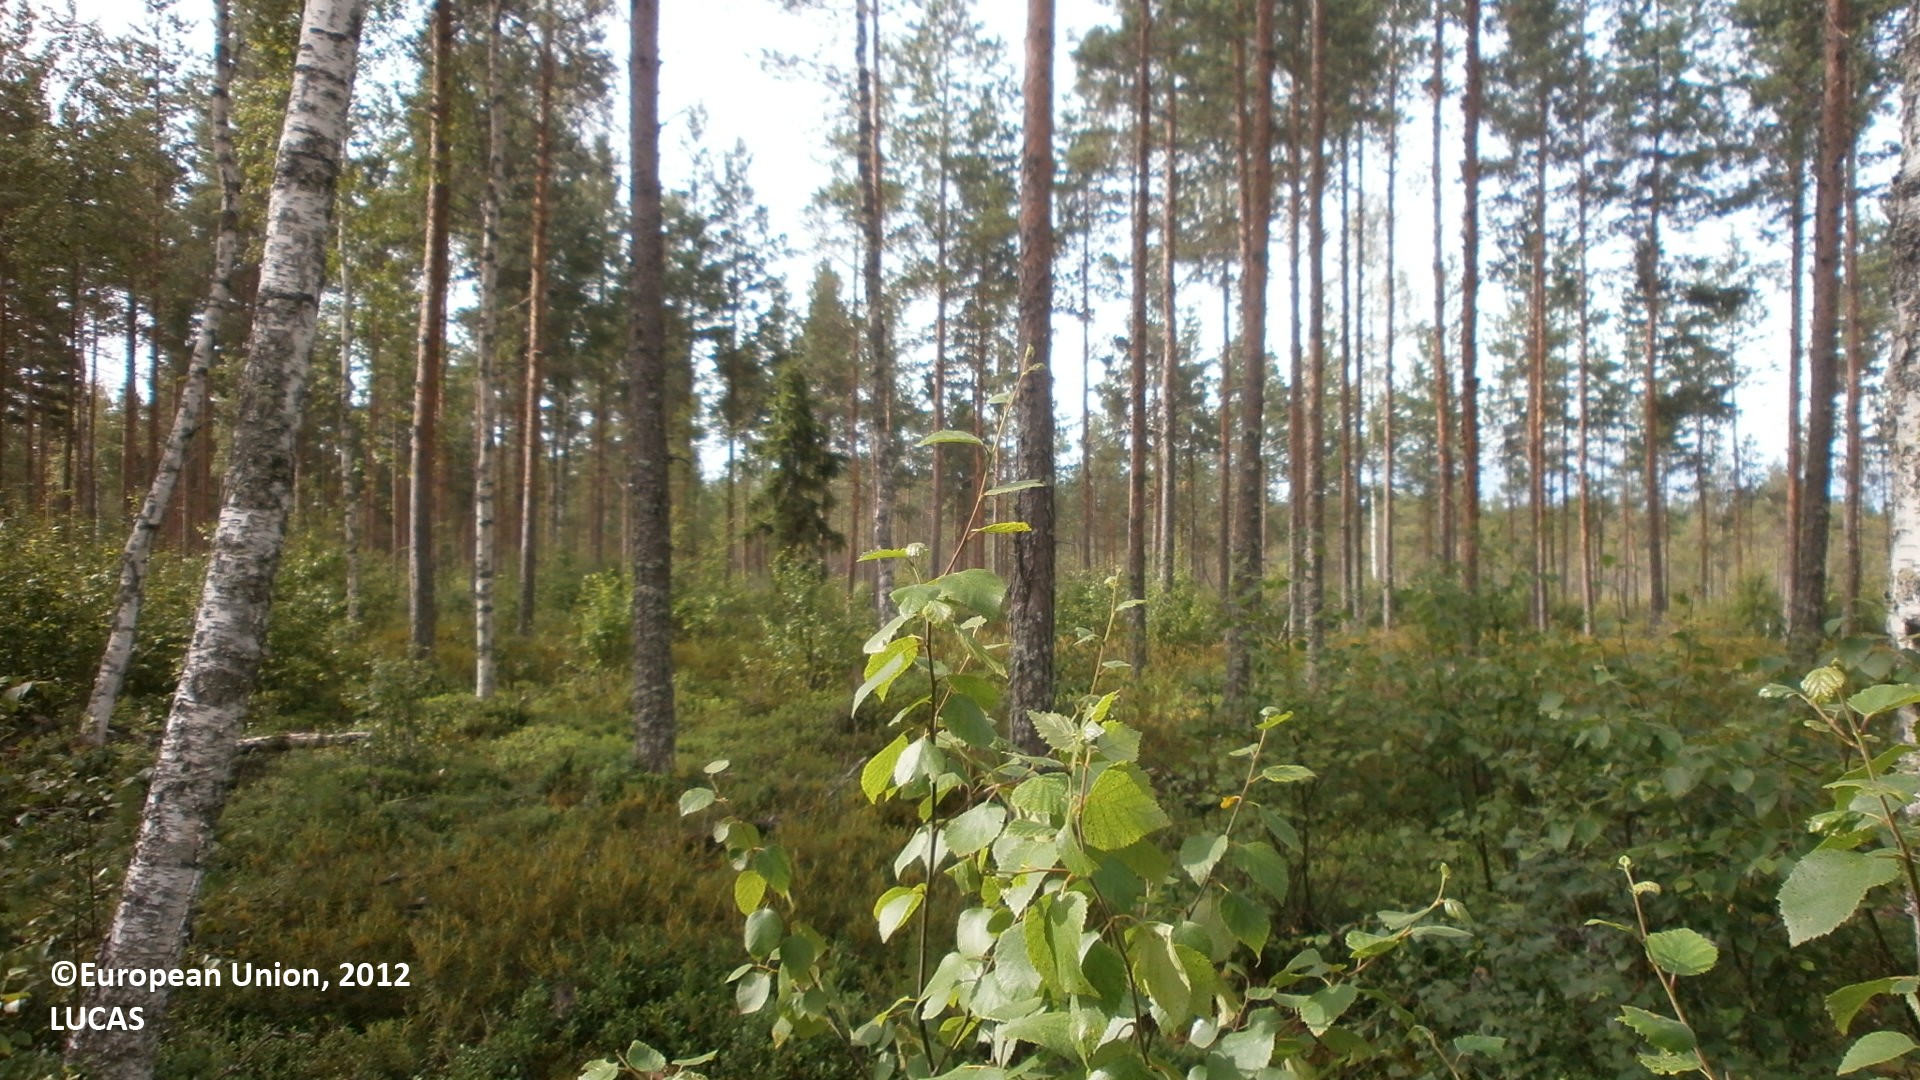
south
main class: Woodland
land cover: Broadleaved woodland
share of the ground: 50 - 75 %
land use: Forestry
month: July
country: FI
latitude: 64.0624
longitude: 24.0616
